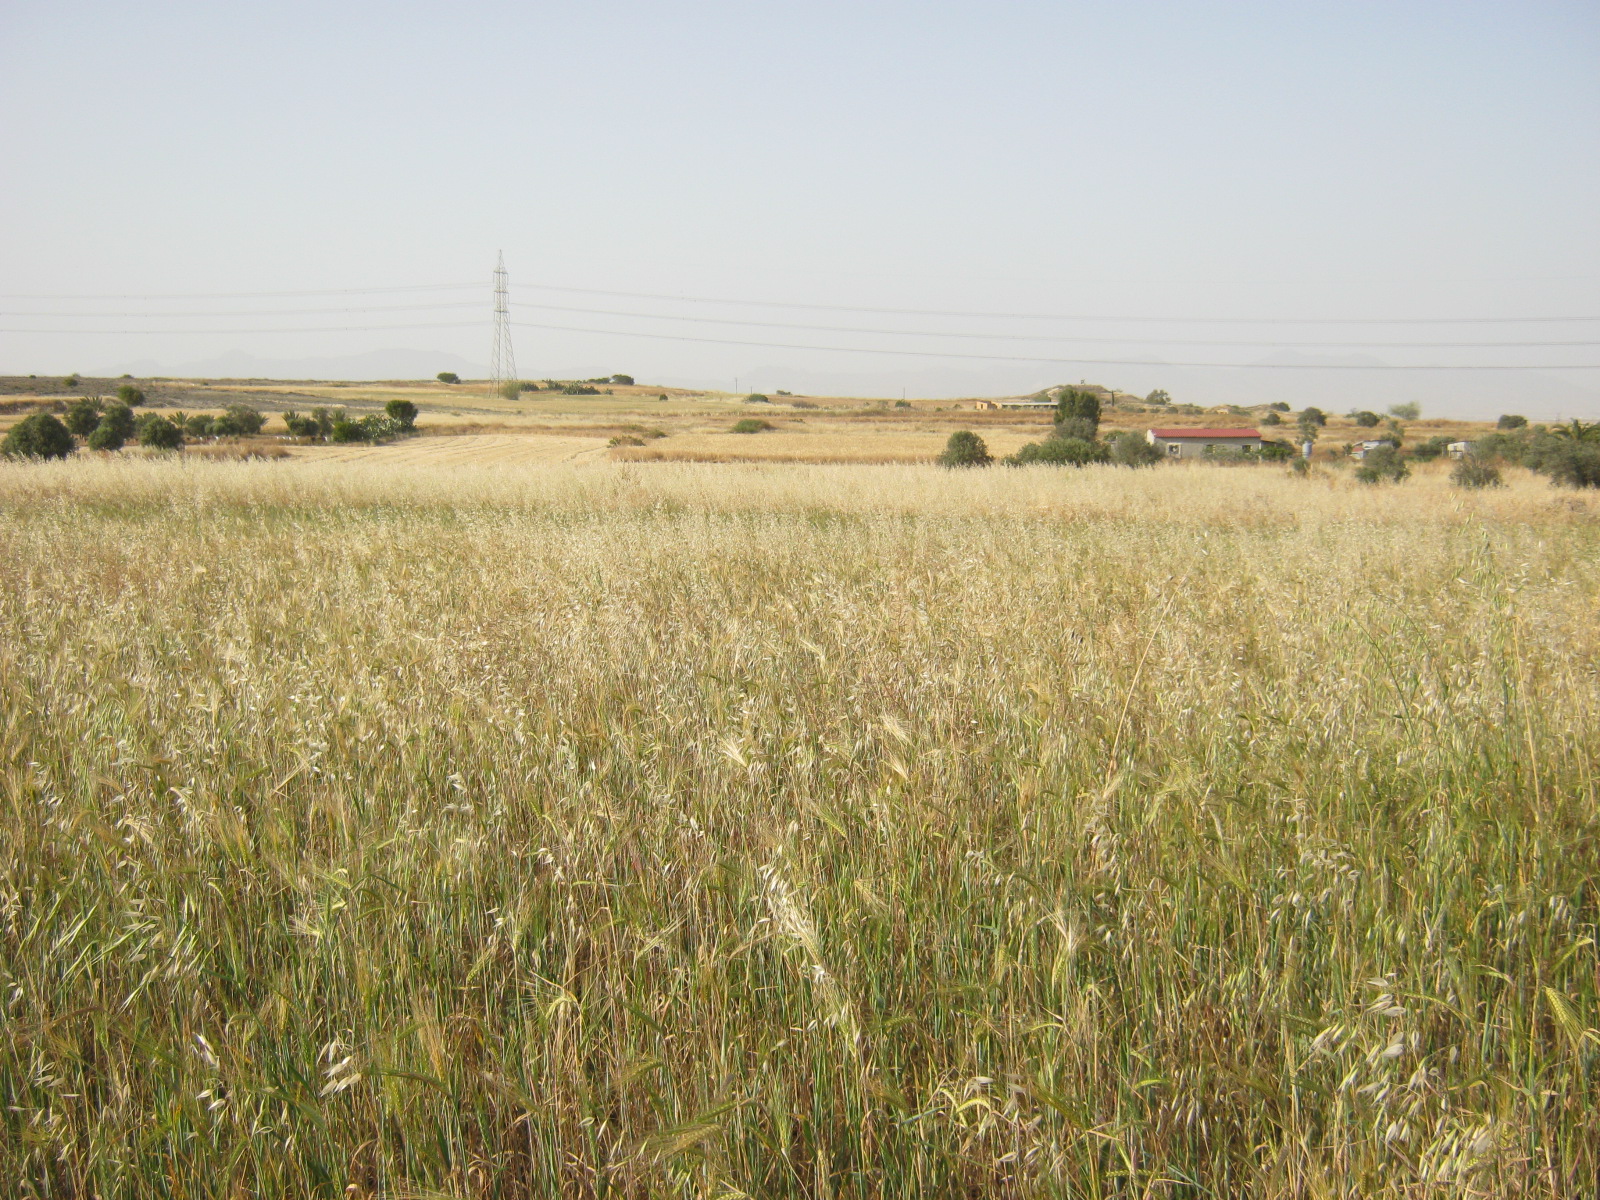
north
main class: Cropland
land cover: Mixed cereals for fodder
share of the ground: > 75 %
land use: Agriculture (excluding fallow land and kitchen gardens)
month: April
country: CY
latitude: 35.1164
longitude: 33.4231
